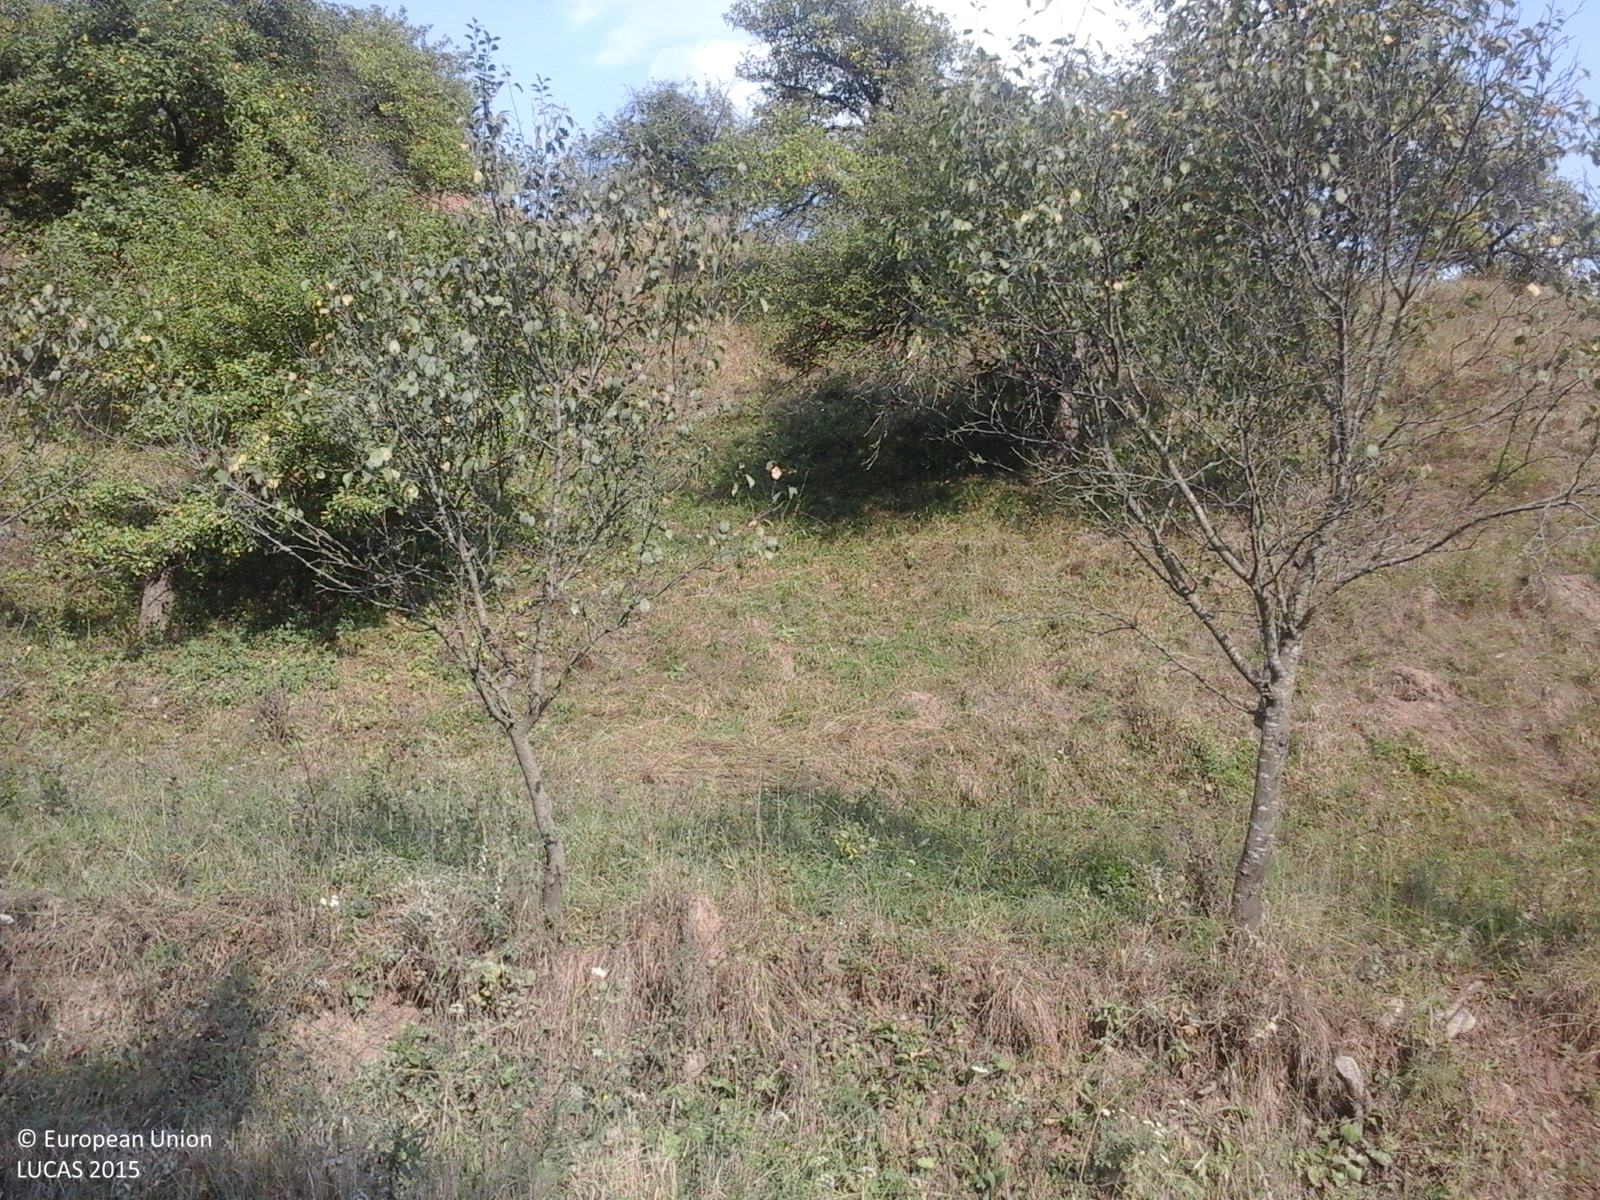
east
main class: Woodland
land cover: Broadleaved woodland
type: floodplain forest
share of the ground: > 75 %
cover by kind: broadleaved forest trees 100 %
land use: Semi-natural and natural areas not in use
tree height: > 5 m
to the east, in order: Broadleaved woodland; Rivers and streams; Grass margins; Paved roads, cycling and walking lanes; Grass margins; Ditches and canals; Other fruit trees and berries; Grassland without tree/shrub cover; Other fruit trees and berries; Grass margins; Tracks; Broadleaved woodland
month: September
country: RO
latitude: 47.2244
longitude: 24.0685
